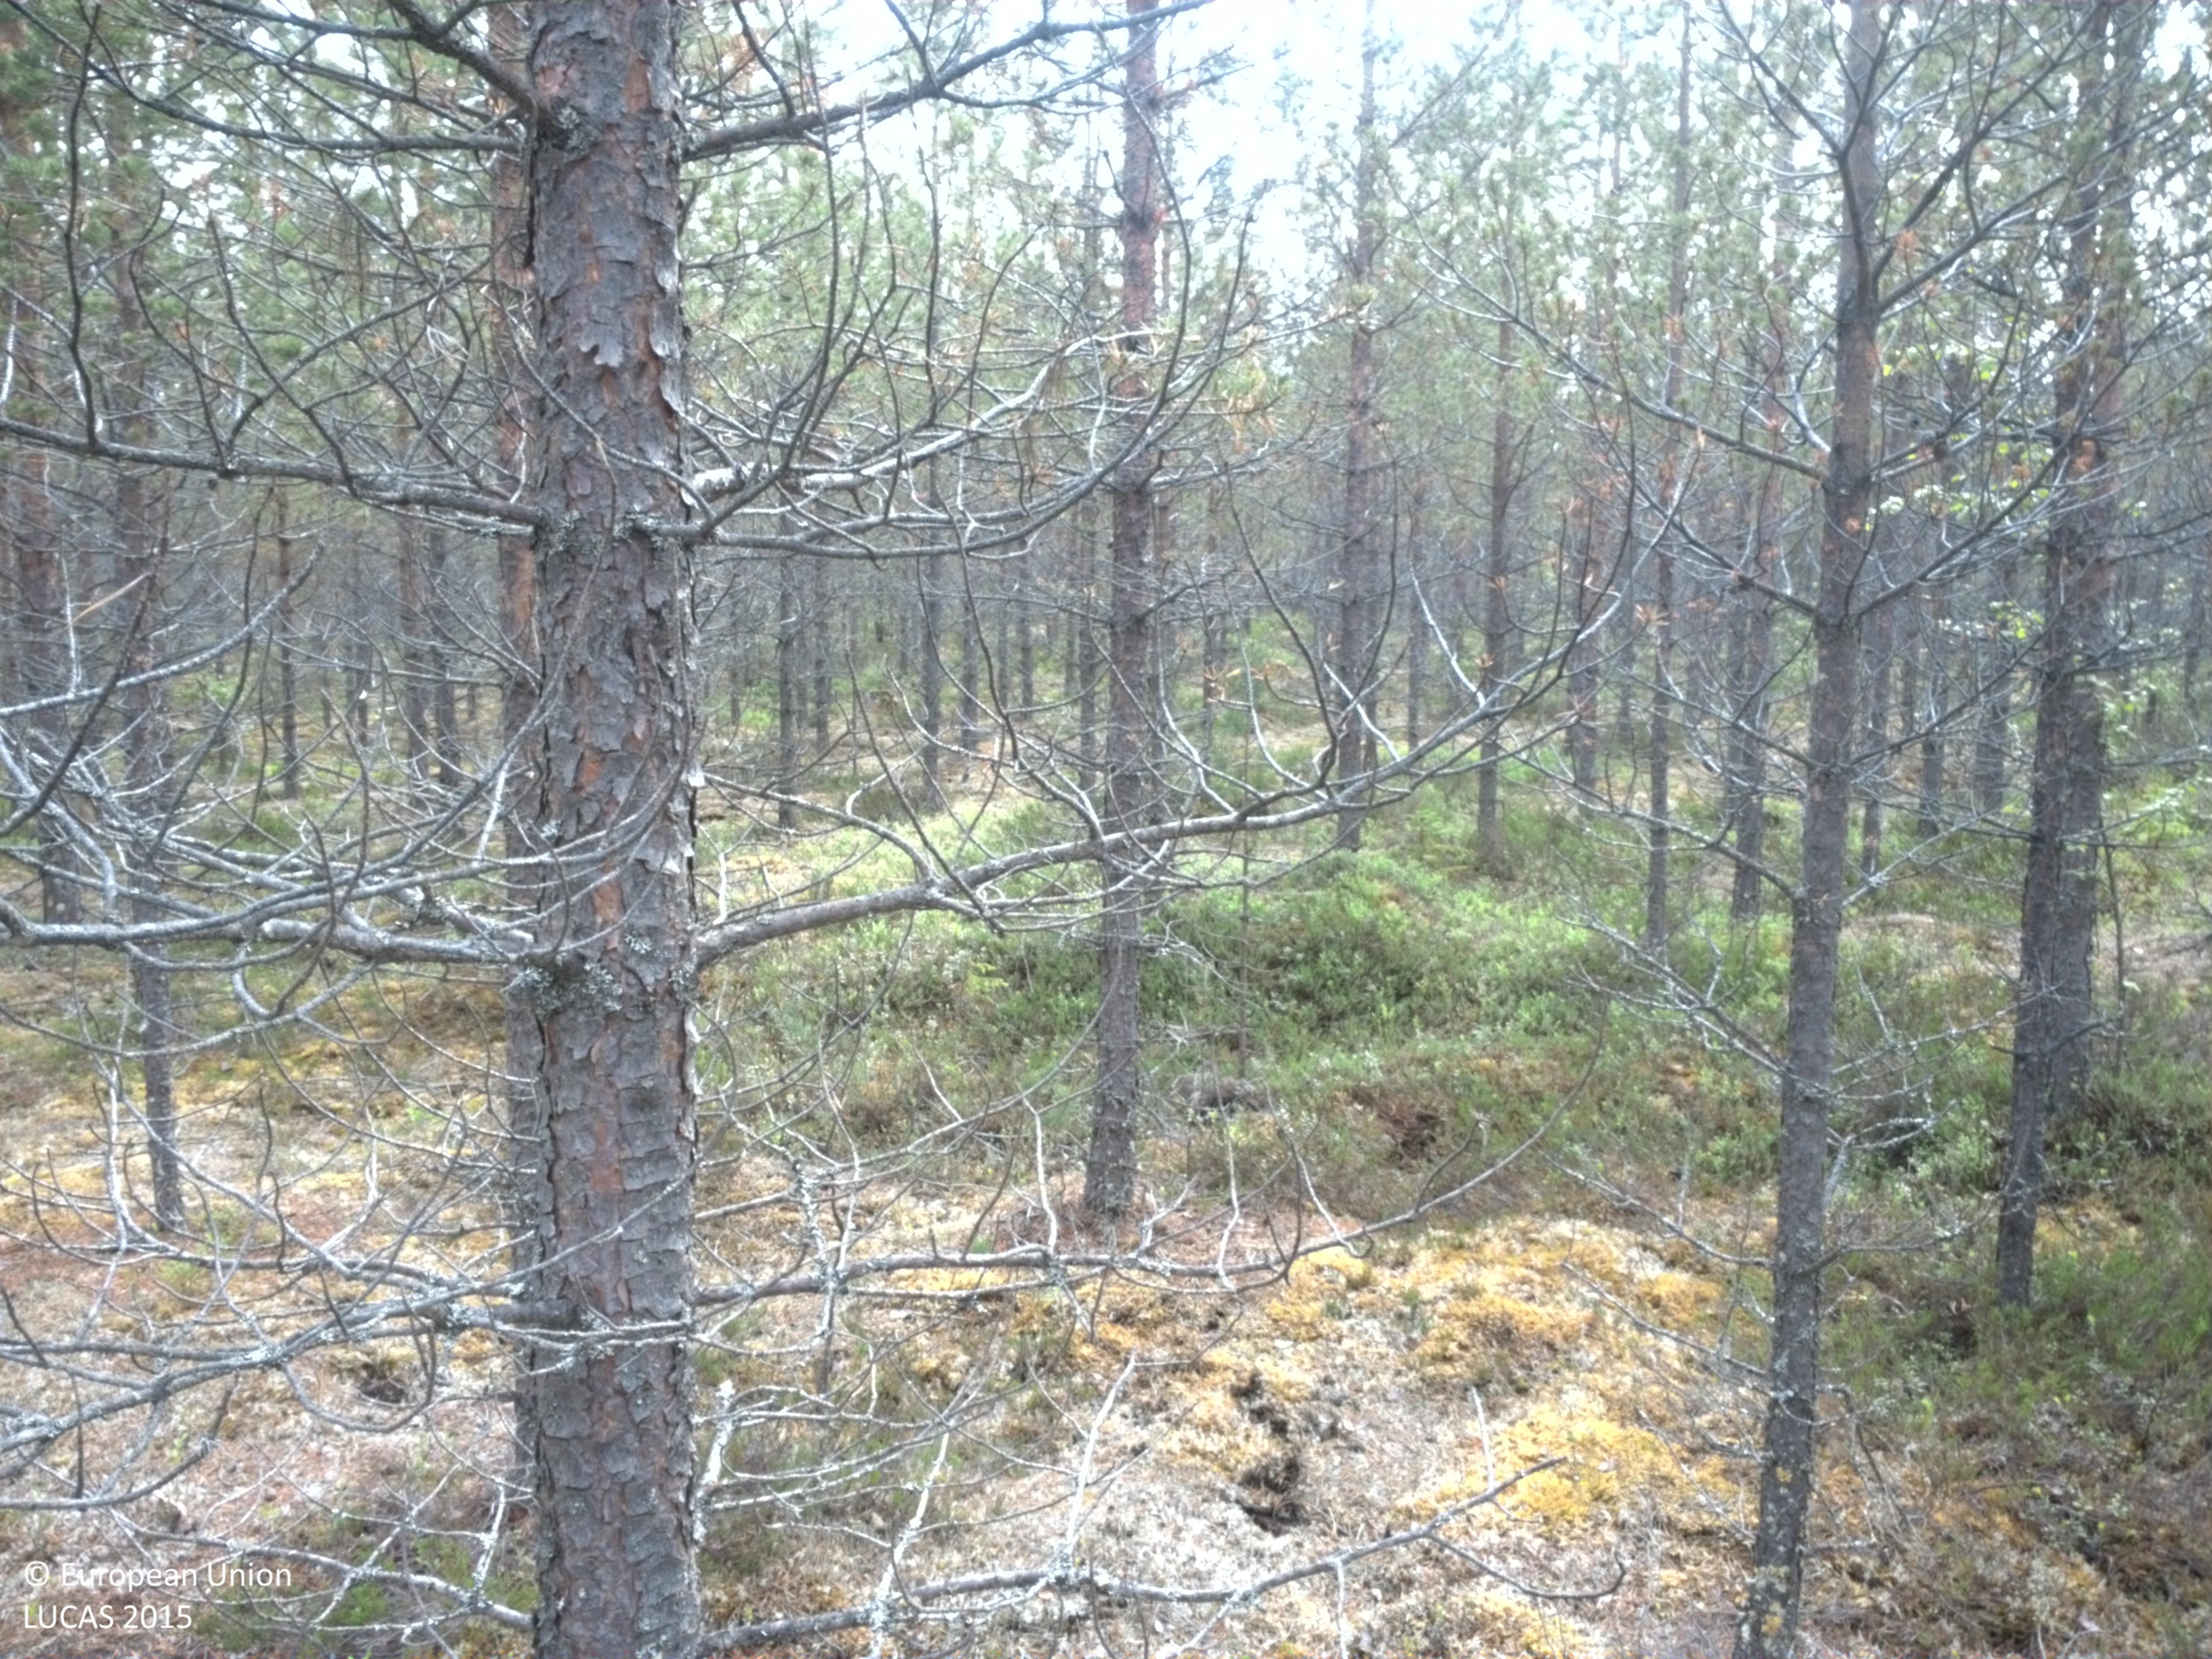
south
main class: Woodland
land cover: Pine dominated coniferous woodland
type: boreal forest
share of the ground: 50 - 75 %
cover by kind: coniferous forest trees 75 %, shrubs 15 %, lichens and mosses 10 %
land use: Forestry
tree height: > 5 m
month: July
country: SE
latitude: 64.7239
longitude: 18.3414
